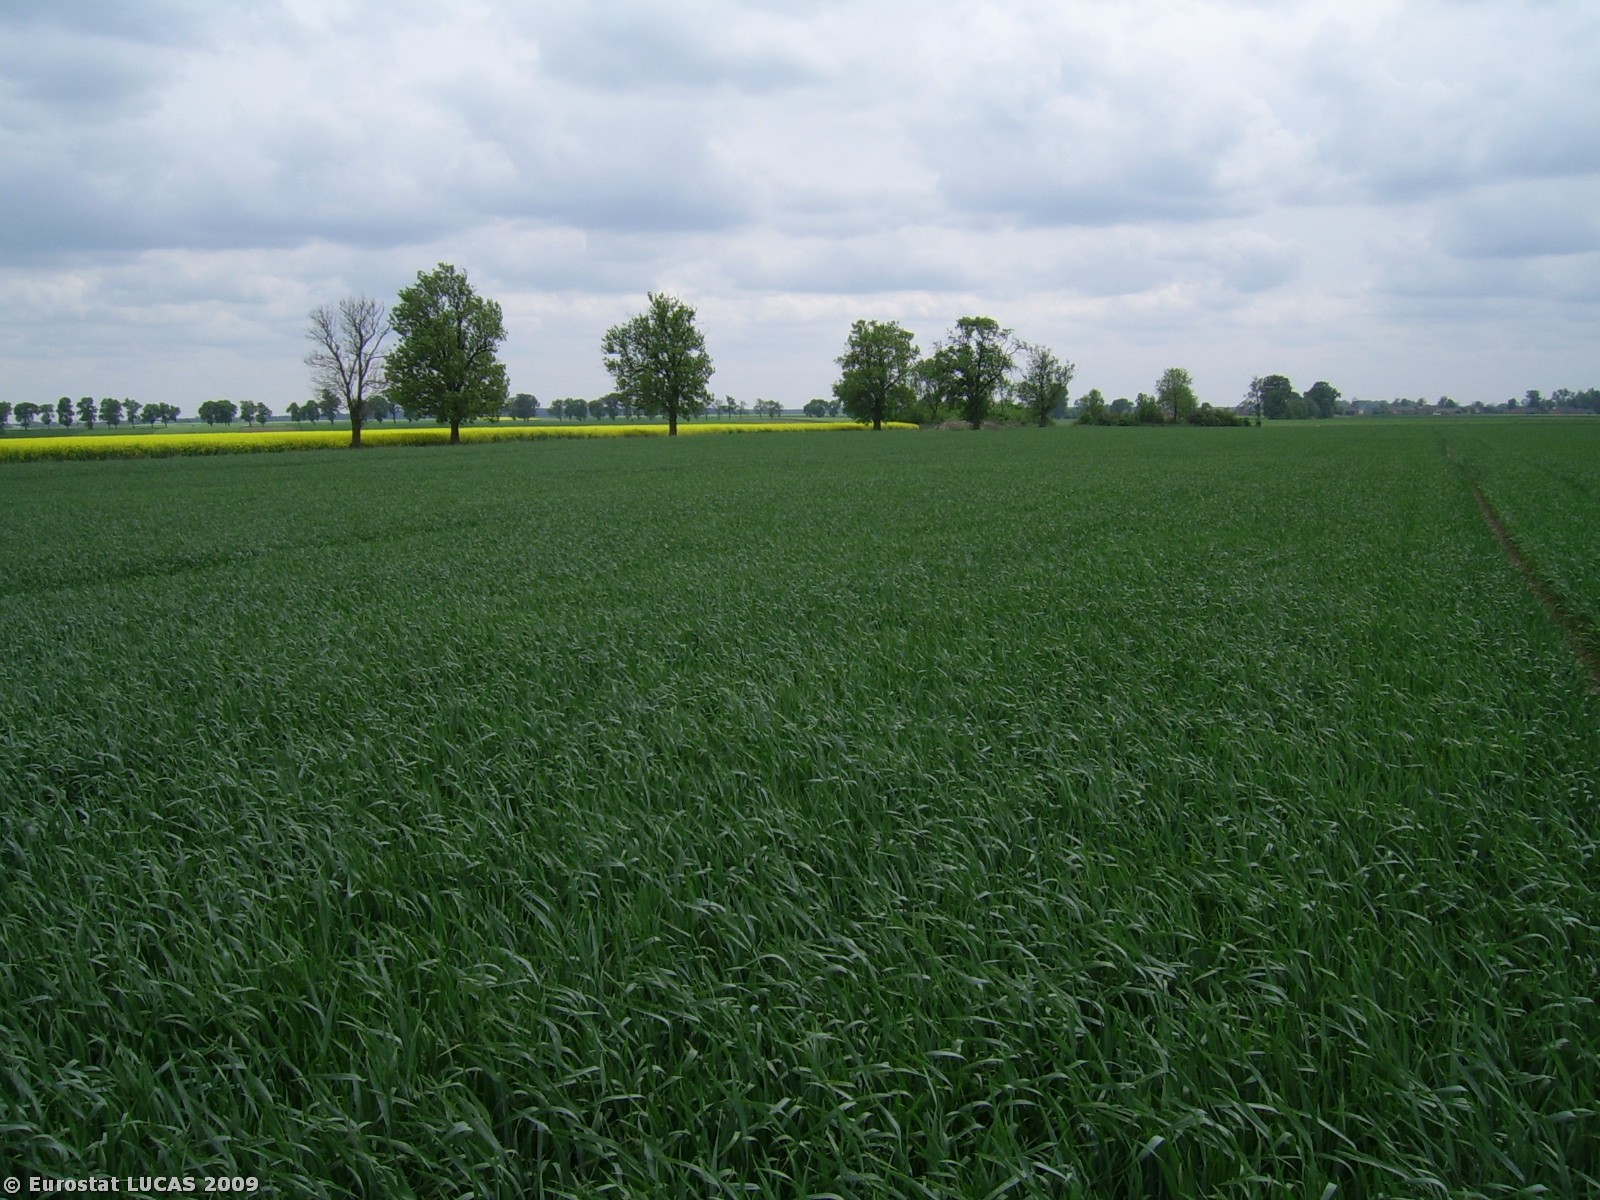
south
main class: Cropland
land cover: Common wheat
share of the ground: > 75 %
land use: Agriculture (excluding fallow land and kitchen gardens)
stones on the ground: < 10 %
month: May
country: PL
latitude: 51.8175
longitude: 16.8711
